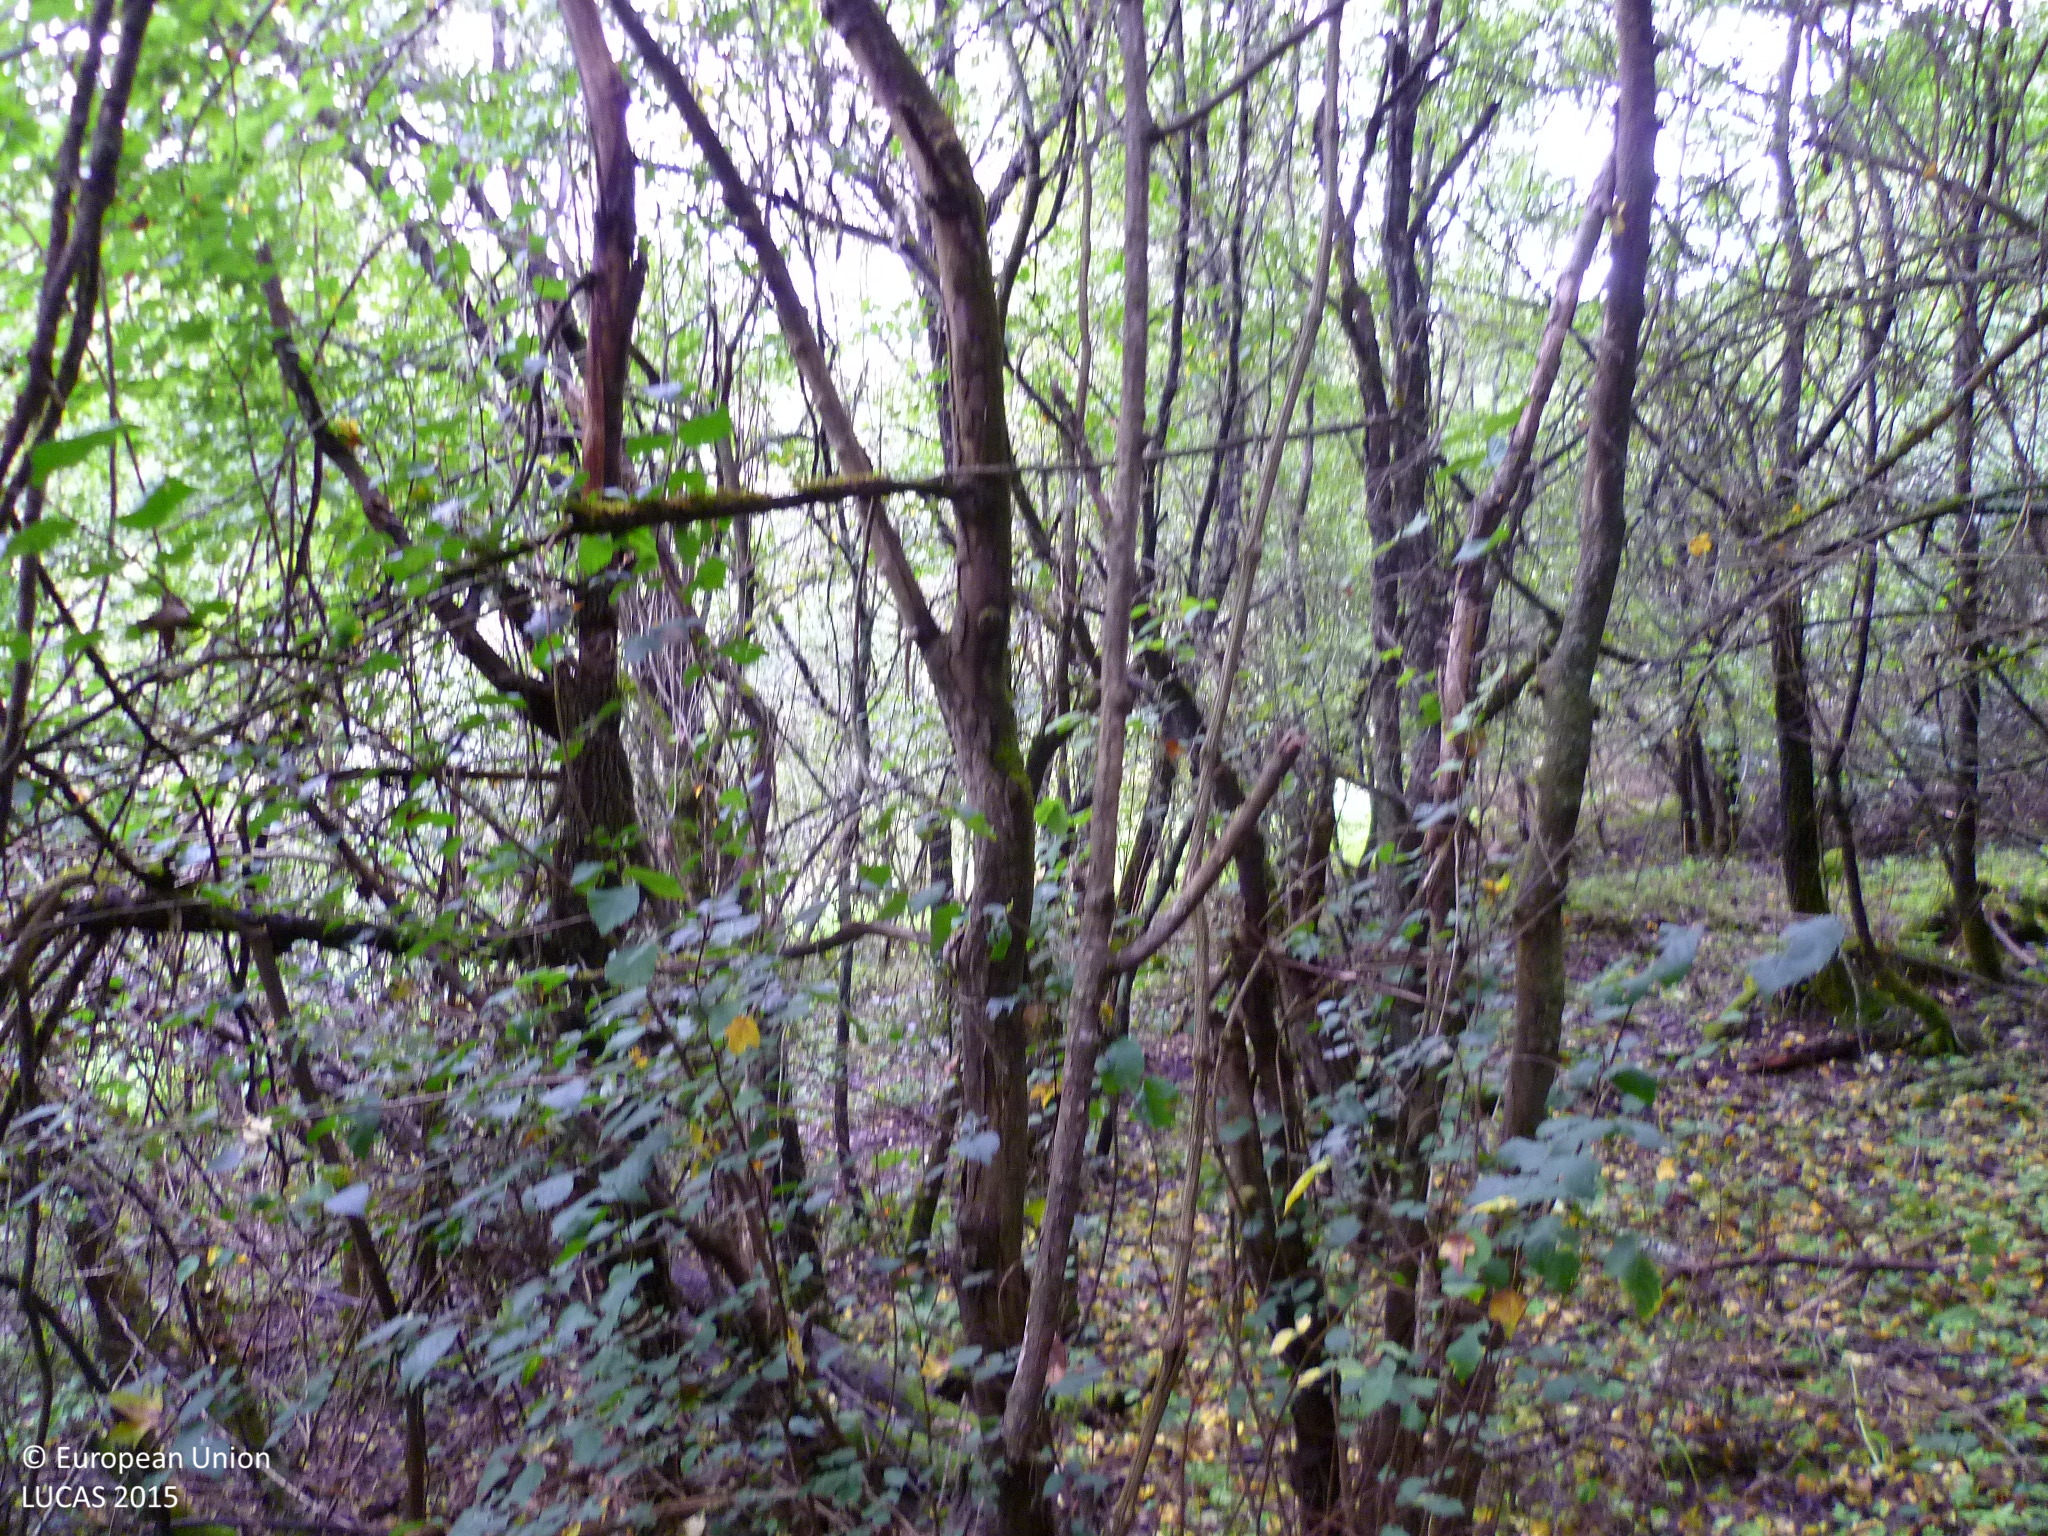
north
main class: Woodland
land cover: Broadleaved woodland
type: mesophytic deciduous forest
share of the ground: > 75 %
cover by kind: broadleaved forest trees 85 %, herbaceous plants 15 %
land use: Forestry
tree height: > 5 m
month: September
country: BG
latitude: 42.5950
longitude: 22.7363
